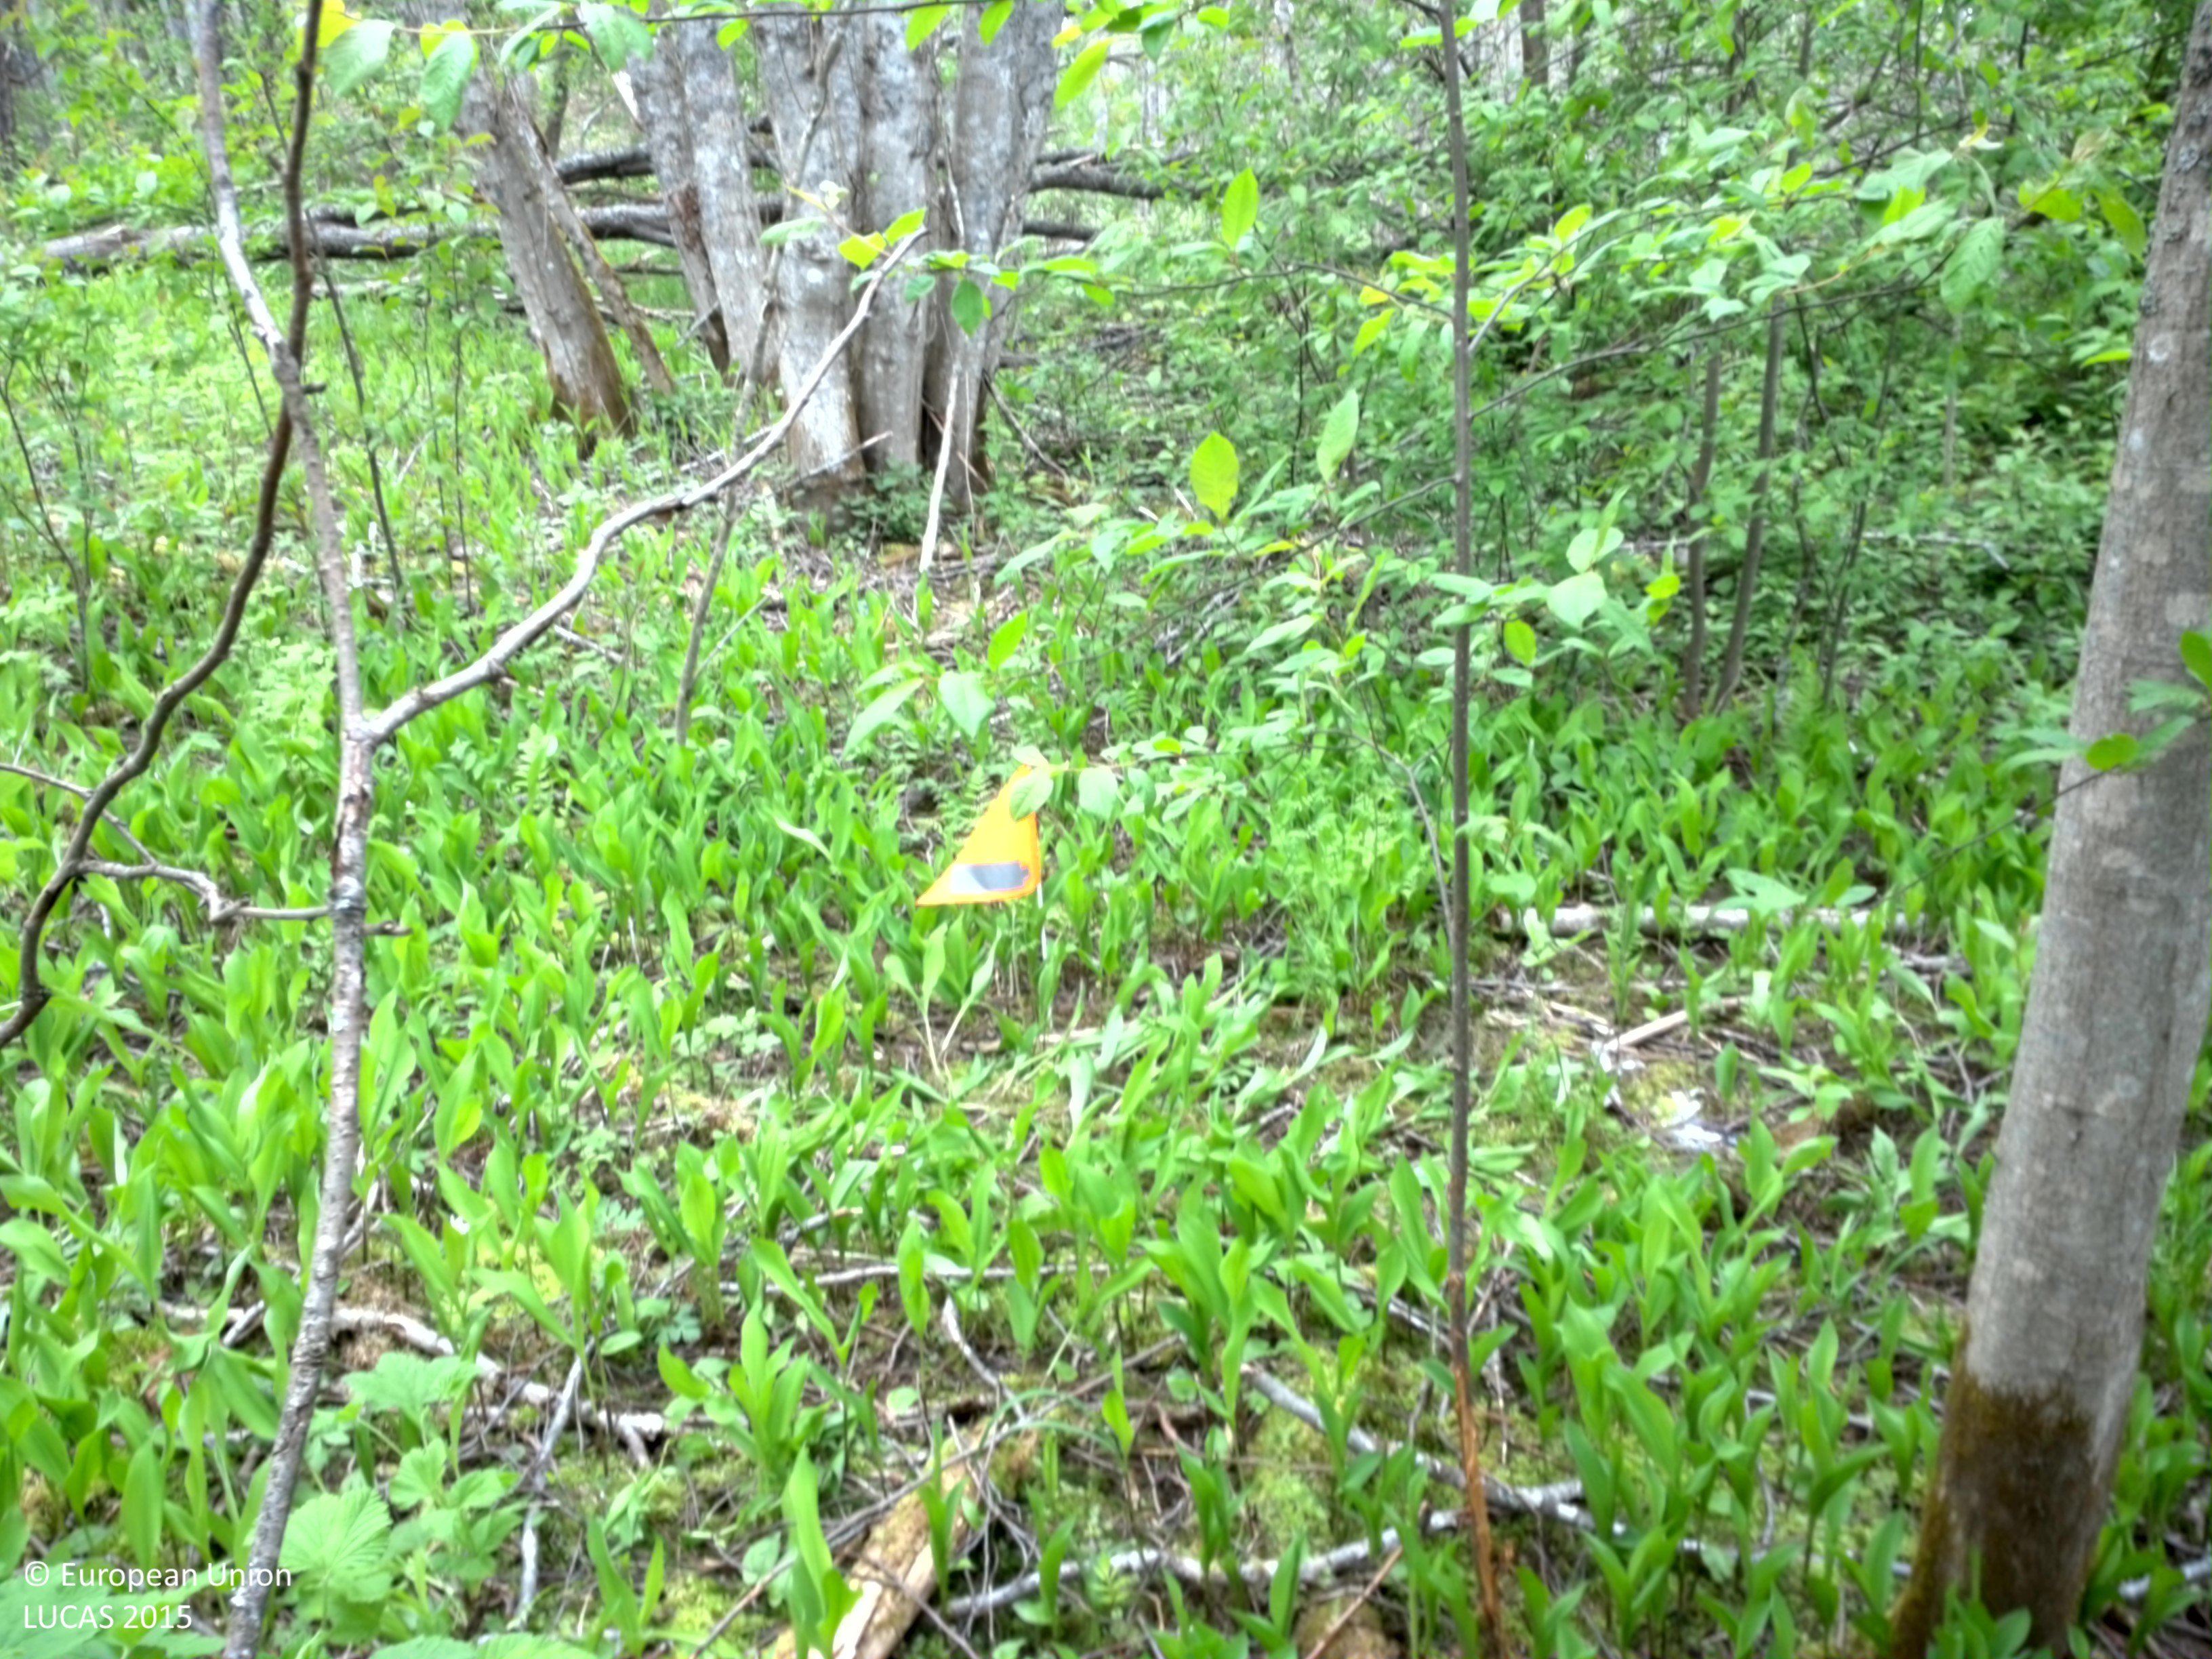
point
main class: Woodland
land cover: Broadleaved woodland
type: hemiboreal forest and nemoral coniferous forest and mixed broadleaved-coniferous forest
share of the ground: > 75 %
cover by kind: broadleaved forest trees 80 %, herbaceous plants 20 %
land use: Forestry
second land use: Amenities, museums, leisure
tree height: > 5 m
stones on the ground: < 10 %
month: May
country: SE
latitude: 60.2836
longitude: 13.4085
